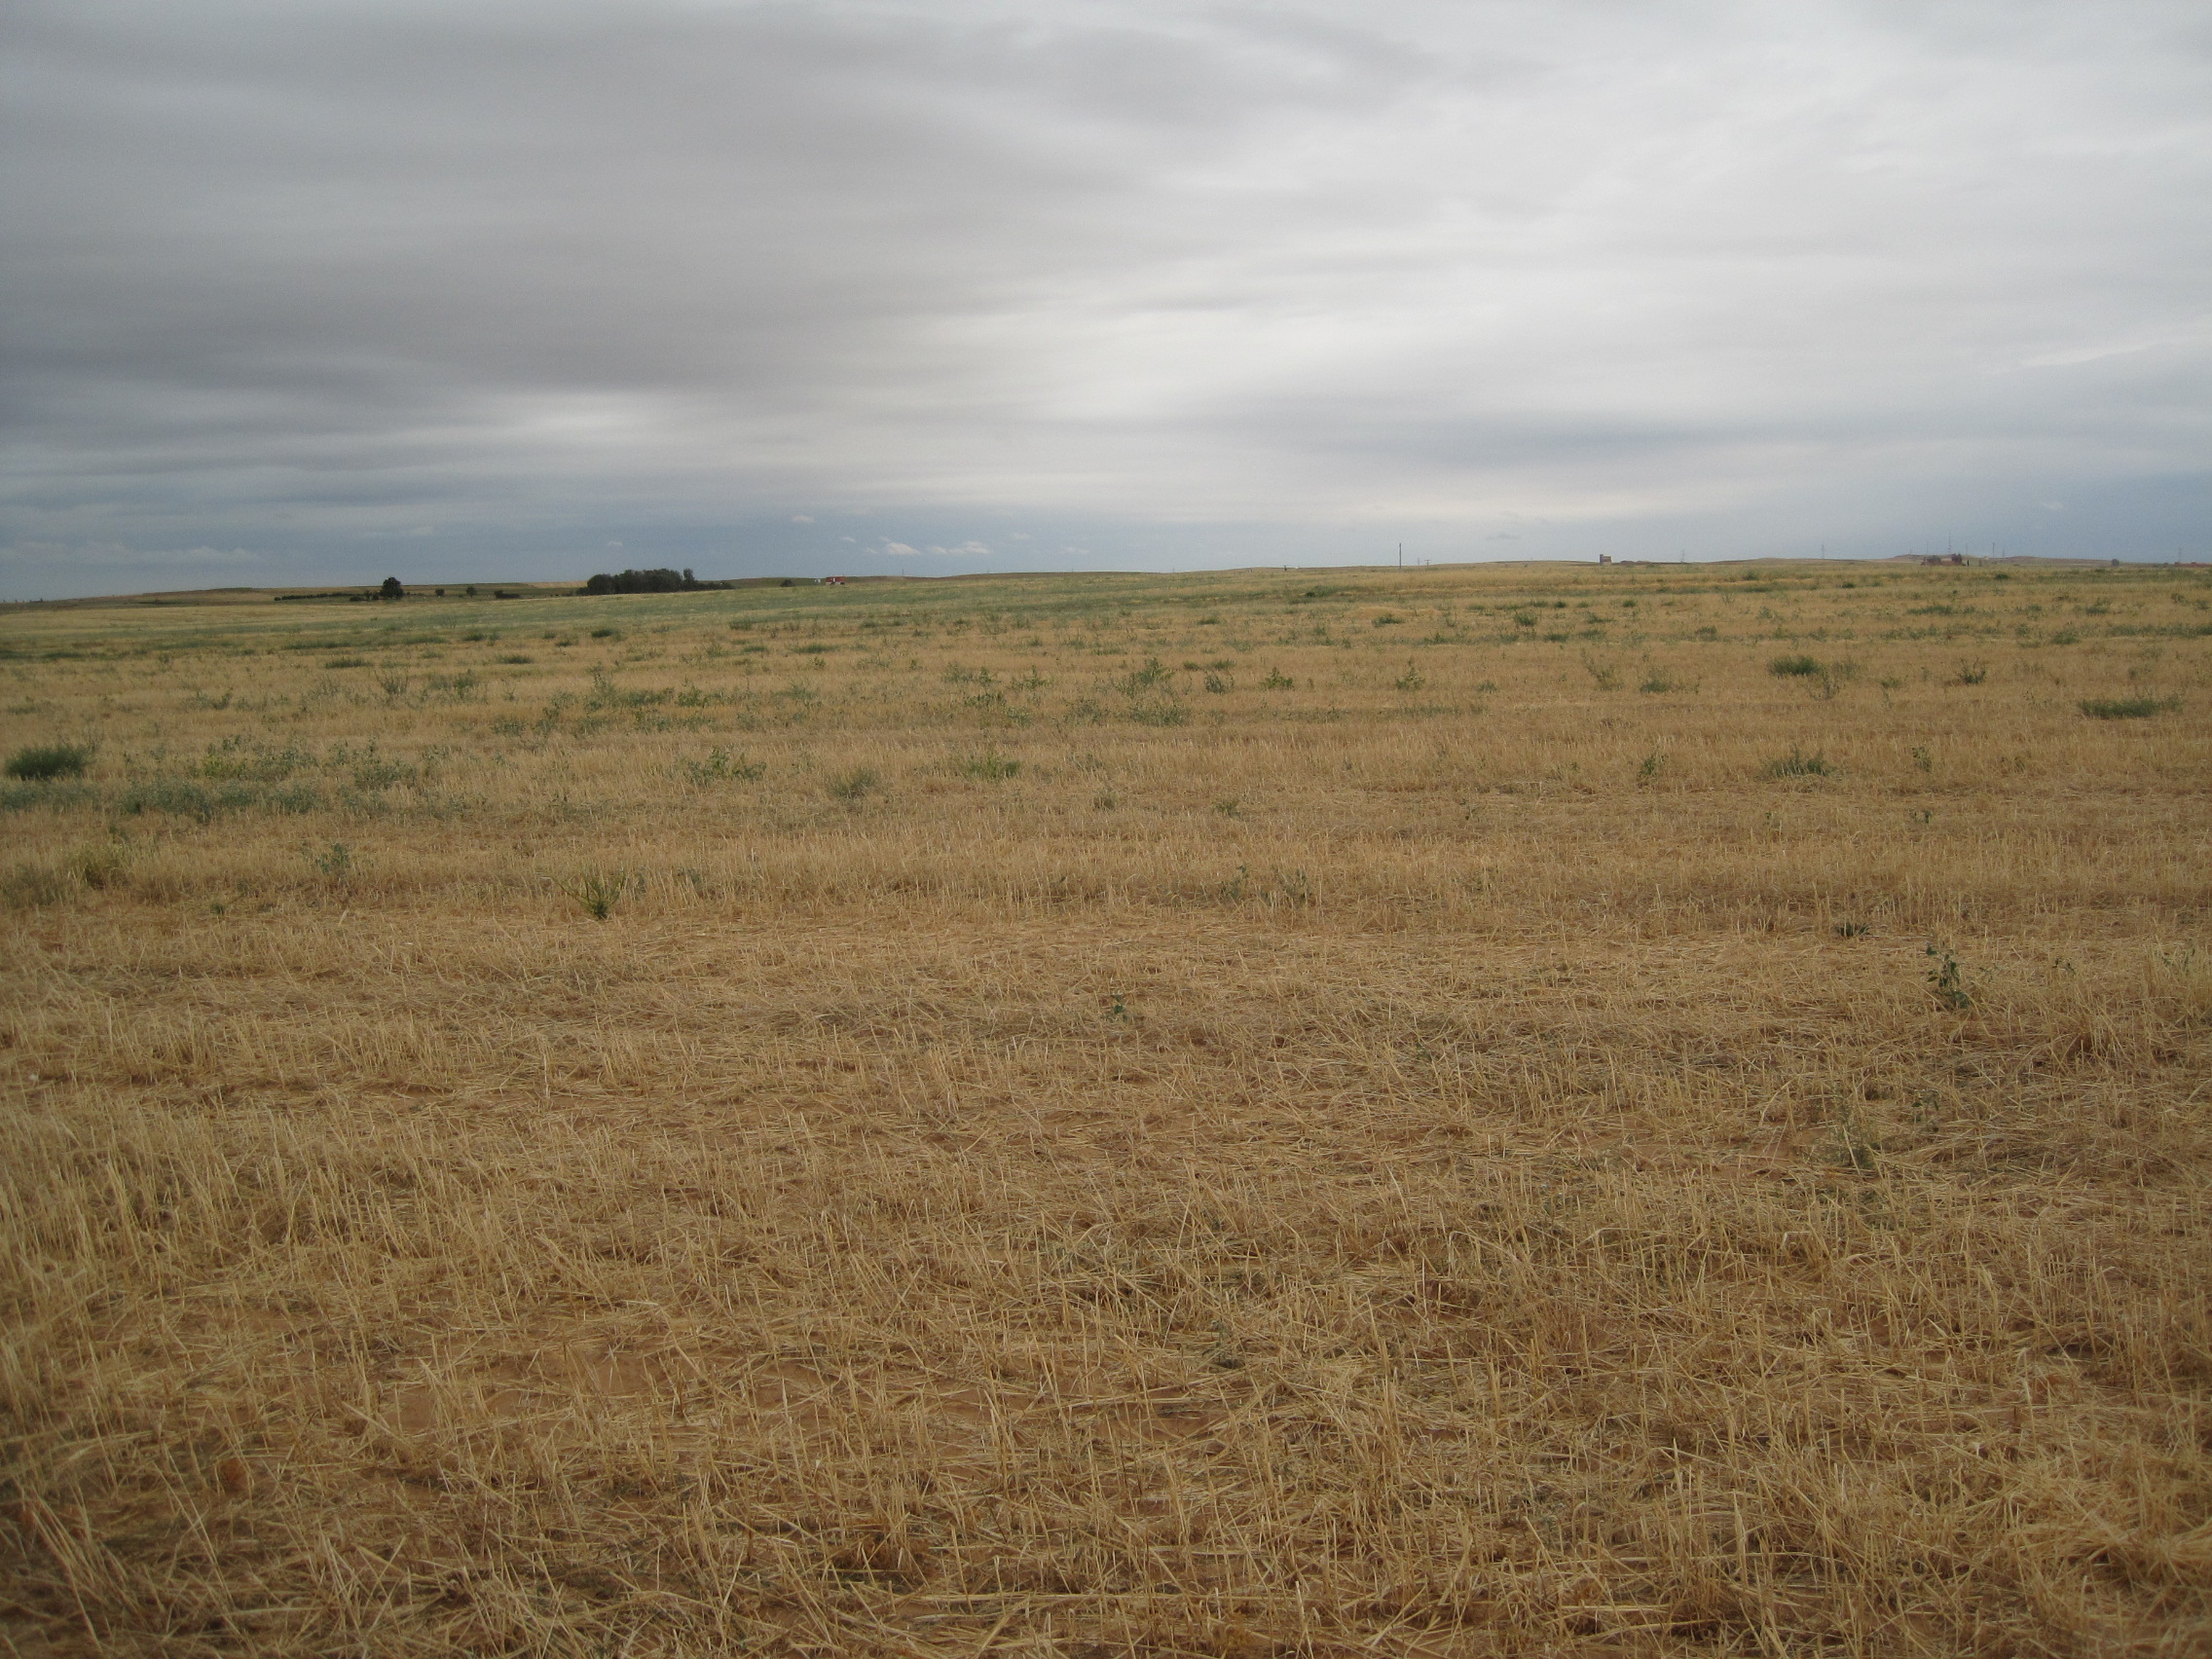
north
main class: Cropland
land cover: Barley
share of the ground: < 10 %
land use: Agriculture (excluding fallow land and kitchen gardens)
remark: Harvested field
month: July
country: ES
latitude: 41.9603
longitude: -5.4210
